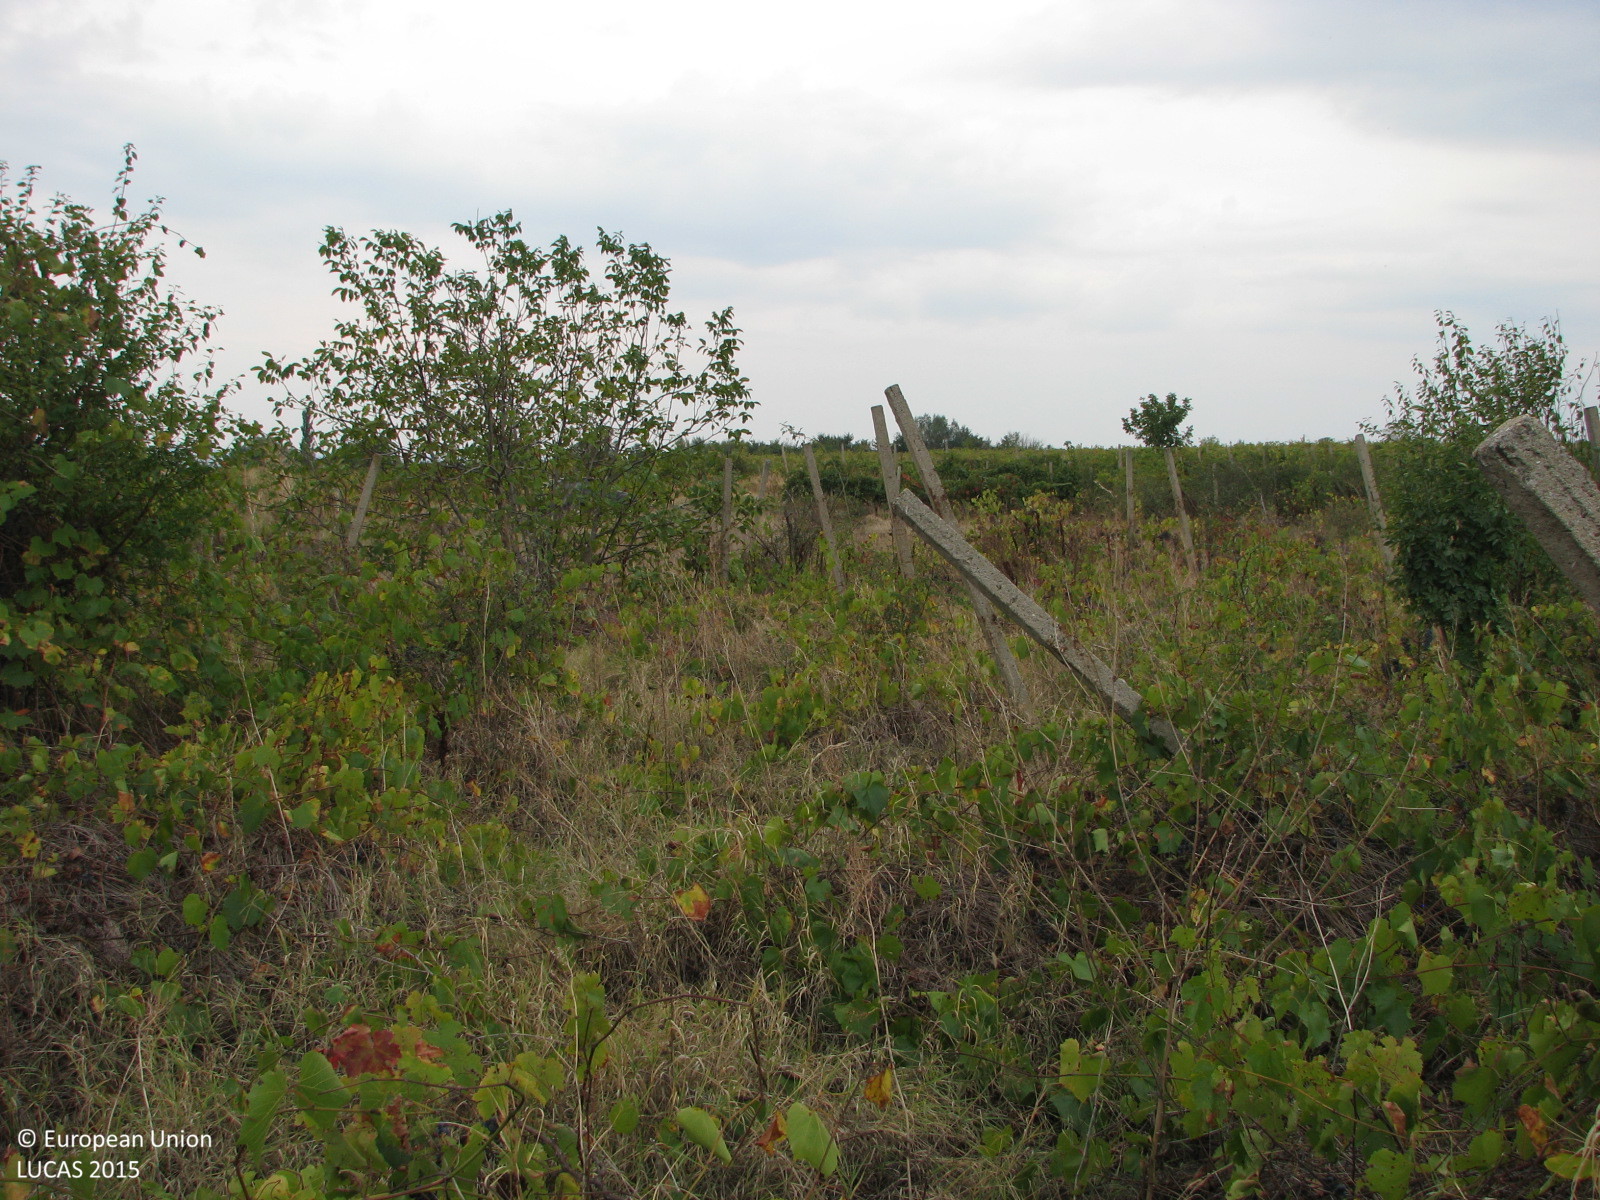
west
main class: Cropland
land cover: Vineyards
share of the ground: > 75 %
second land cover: Spontaneously vegetated surfaces
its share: 50 - 75 %
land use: Agriculture (excluding fallow land and kitchen gardens)
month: October
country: BG
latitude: 42.5685
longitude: 26.1031
